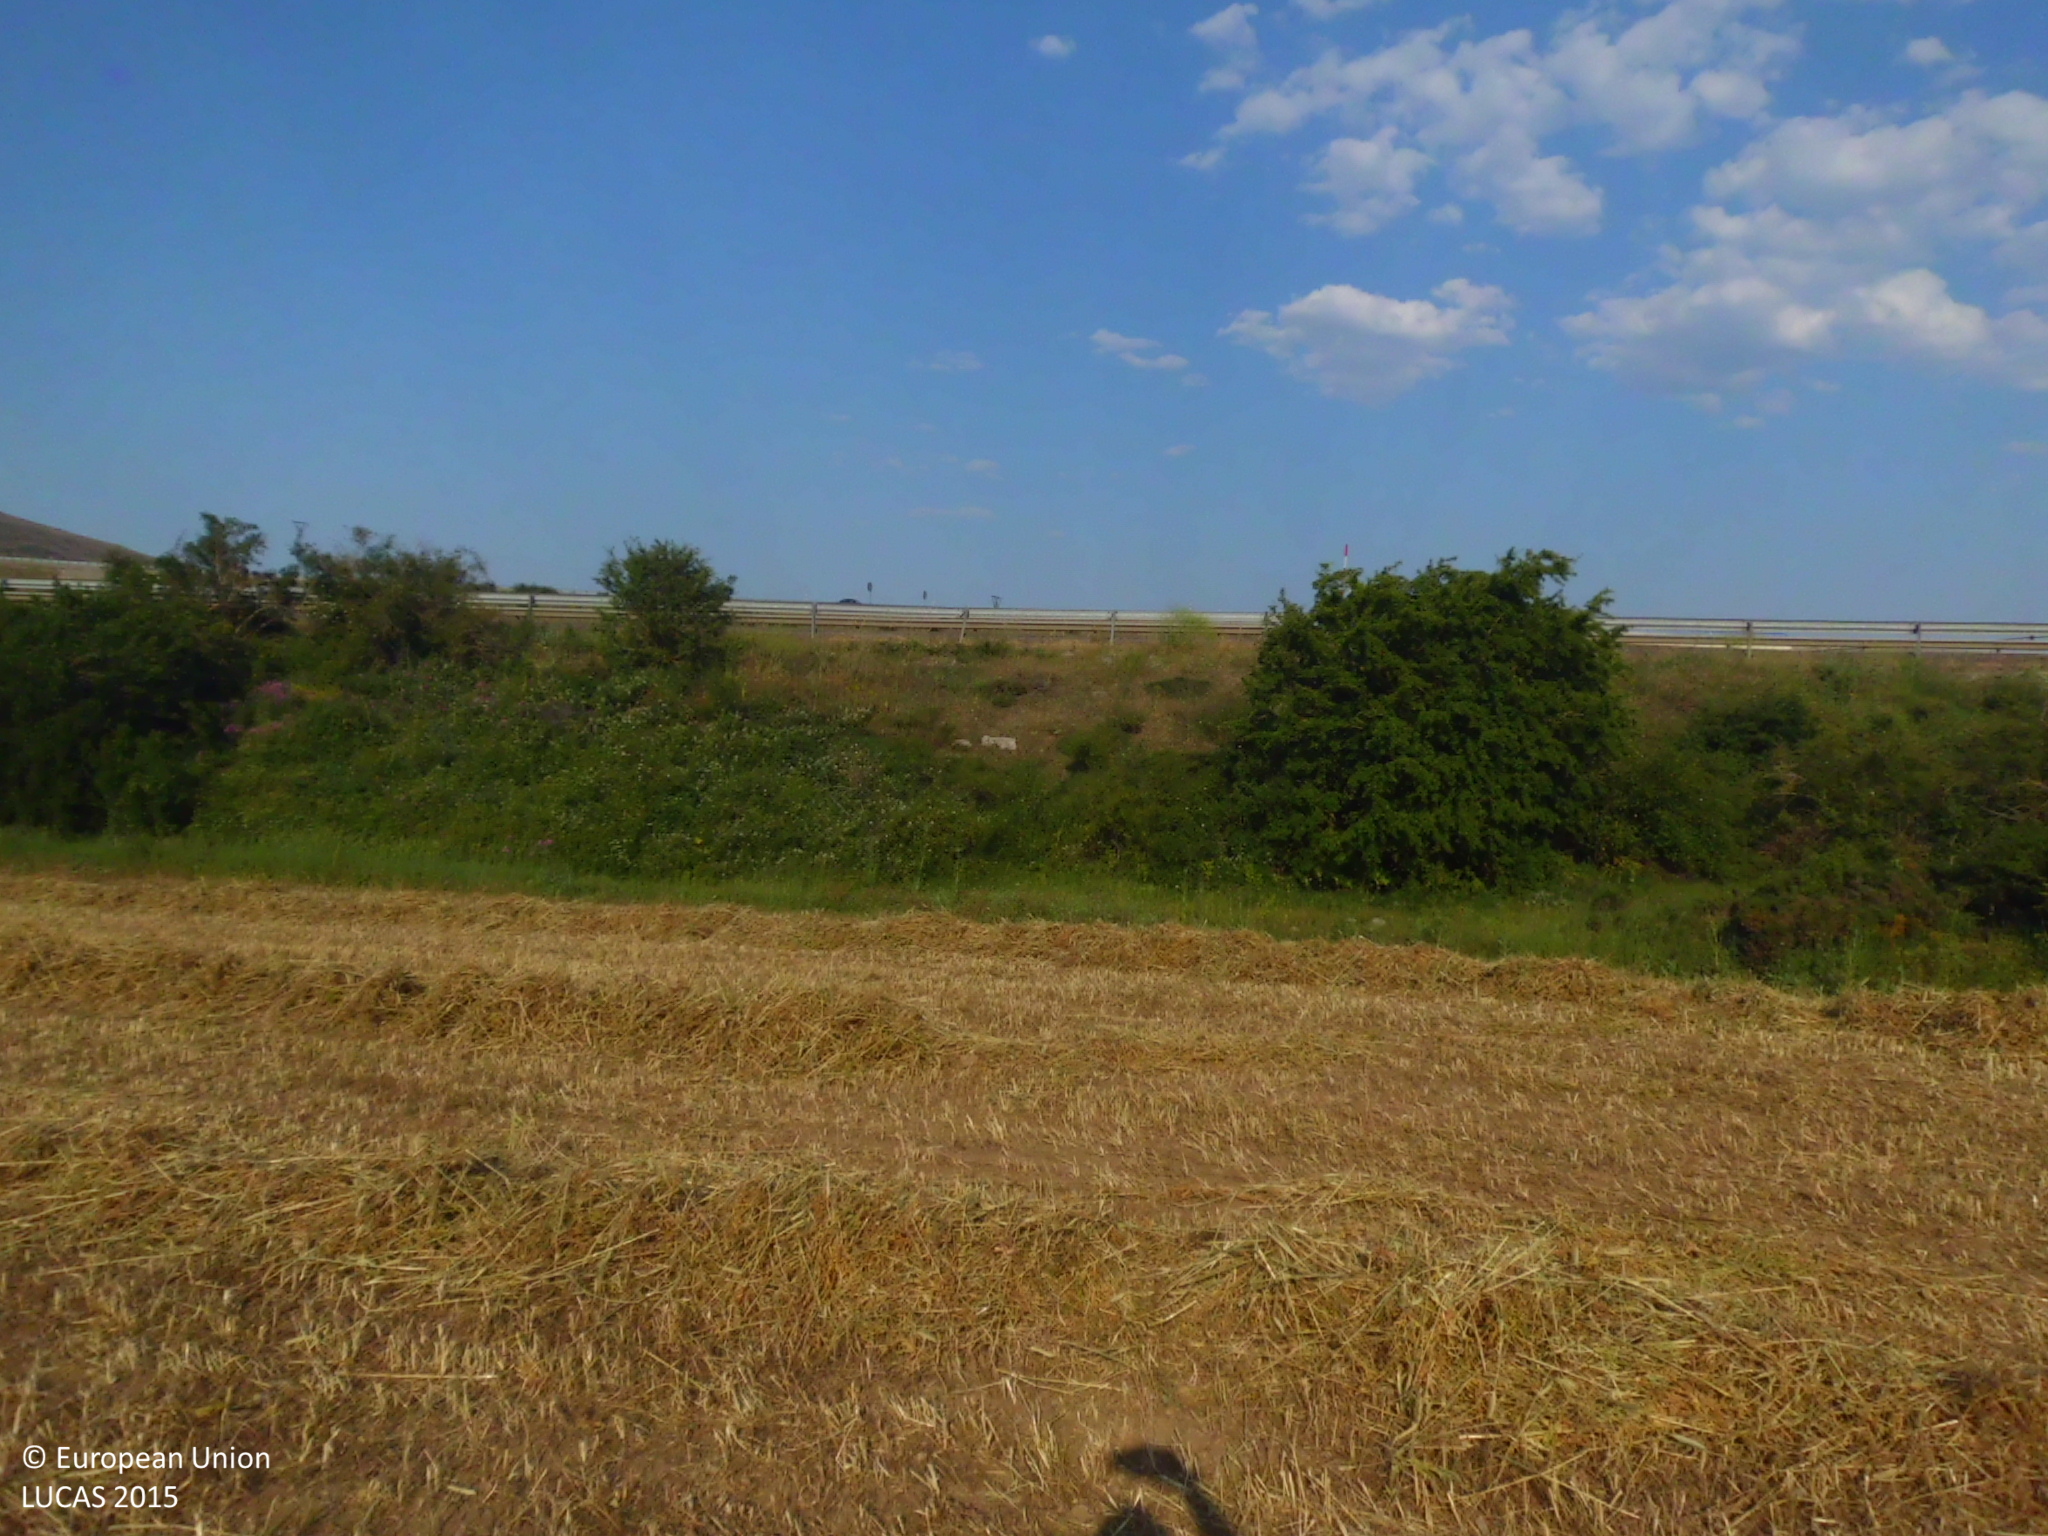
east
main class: Cropland
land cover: Other leguminous and mixtures for fodder
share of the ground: < 10 %
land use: Agriculture (excluding fallow land and kitchen gardens)
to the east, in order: Other leguminous and mixtures for fodder; Grassland with sparse tree/shrub cover; Paved roads, cycling and walking lanes; Grassland with sparse tree/shrub cover; Paved roads, cycling and walking lanes; Grassland with sparse tree/shrub cover; Tracks; Grassland with sparse tree/shrub cover; Fences; Grassland without tree/shrub cover; Paved roads, cycling and walking lanes; Grassland without tree/shrub cover; Ditches and canals; Grassland without tree/shrub cover; Paved roads, cycling and walking lanes; Grassland without tree/shrub cover; Fences; Grassland without tree/shrub cover
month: June
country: ES
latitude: 42.9036
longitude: -4.1214
